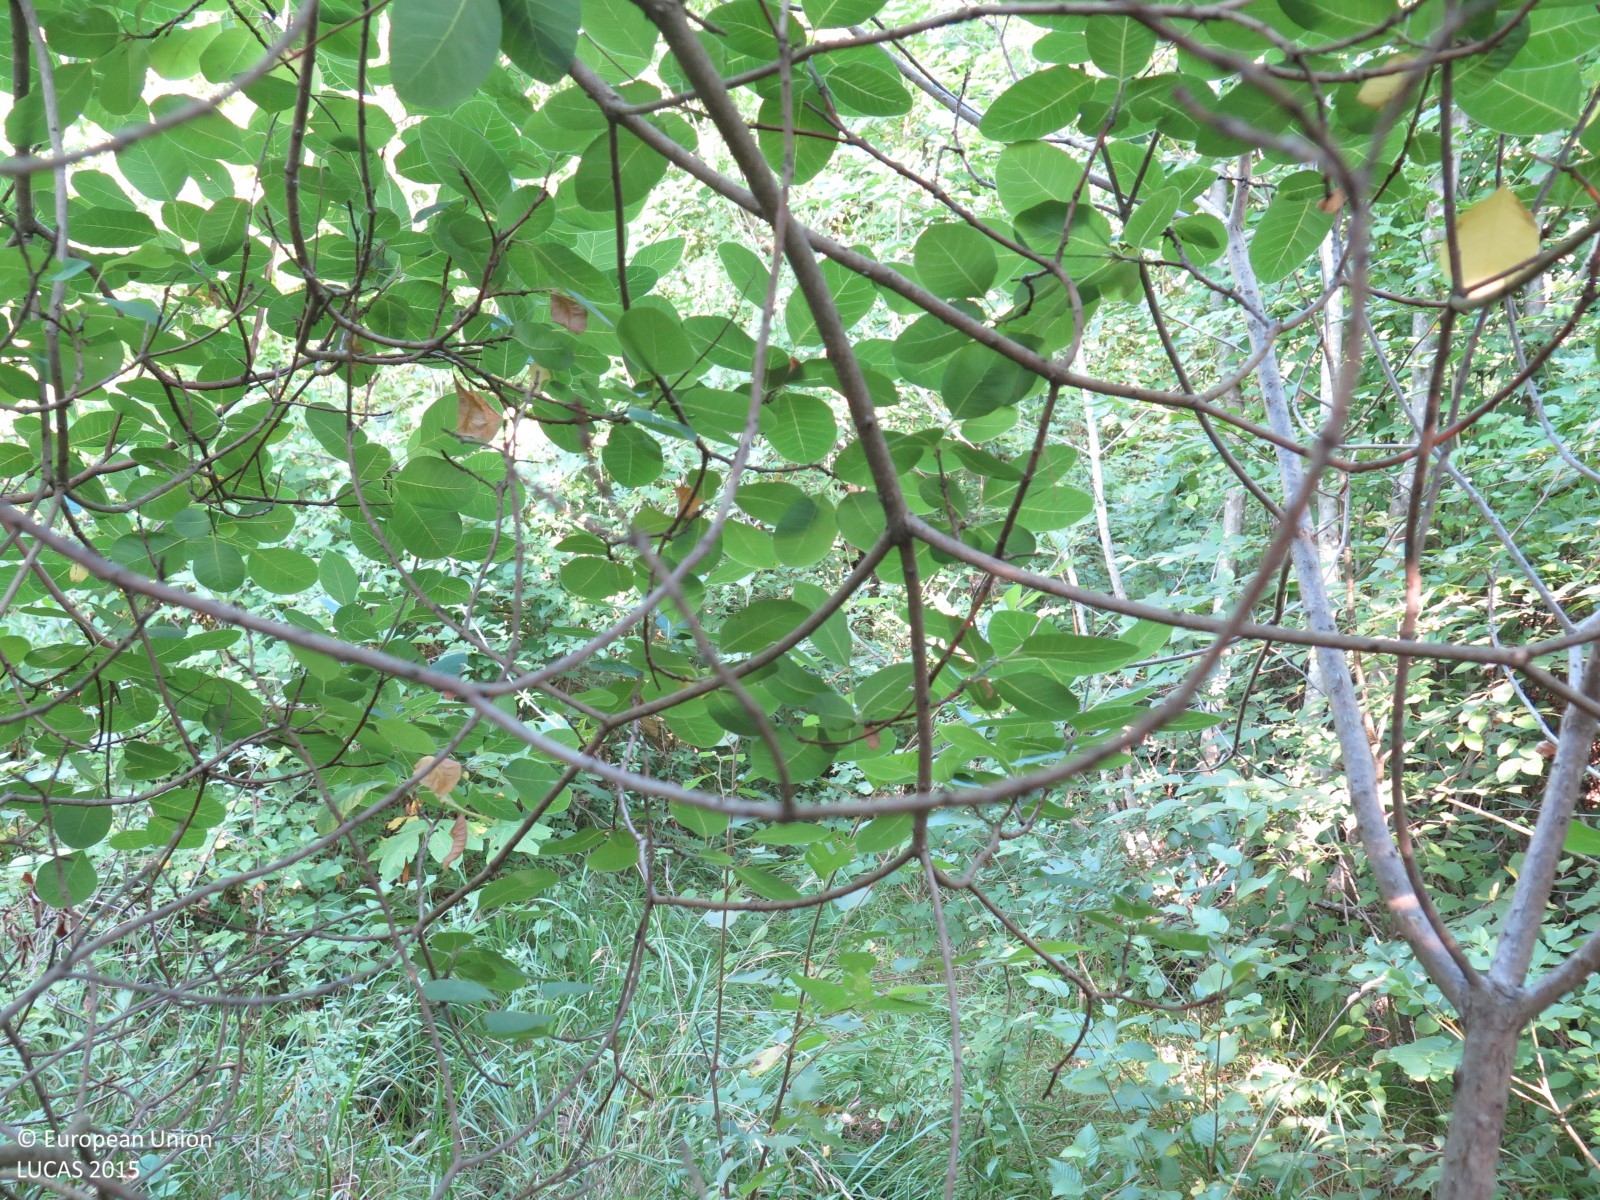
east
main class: Woodland
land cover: Broadleaved woodland
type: acidophilous oak and oak-birch forest
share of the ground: > 75 %
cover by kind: broadleaved forest trees 90 %, shrubs 5 %, herbaceous plants 5 %
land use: Semi-natural and natural areas not in use
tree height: > 5 m
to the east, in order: Broadleaved woodland; Grassland without tree/shrub cover; Abandoned hedges; Dry stone walls; Grass margins; Paved roads, cycling and walking lanes; Ditches and canals; Shrubland with sparse tree cover; Dry stone walls; Broadleaved woodland; Other fresh vegetables; Grassland without tree/shrub cover; Broadleaved woodland; Dry stone walls; Broadleaved woodland
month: July
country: HR
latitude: 45.3719
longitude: 14.0683
